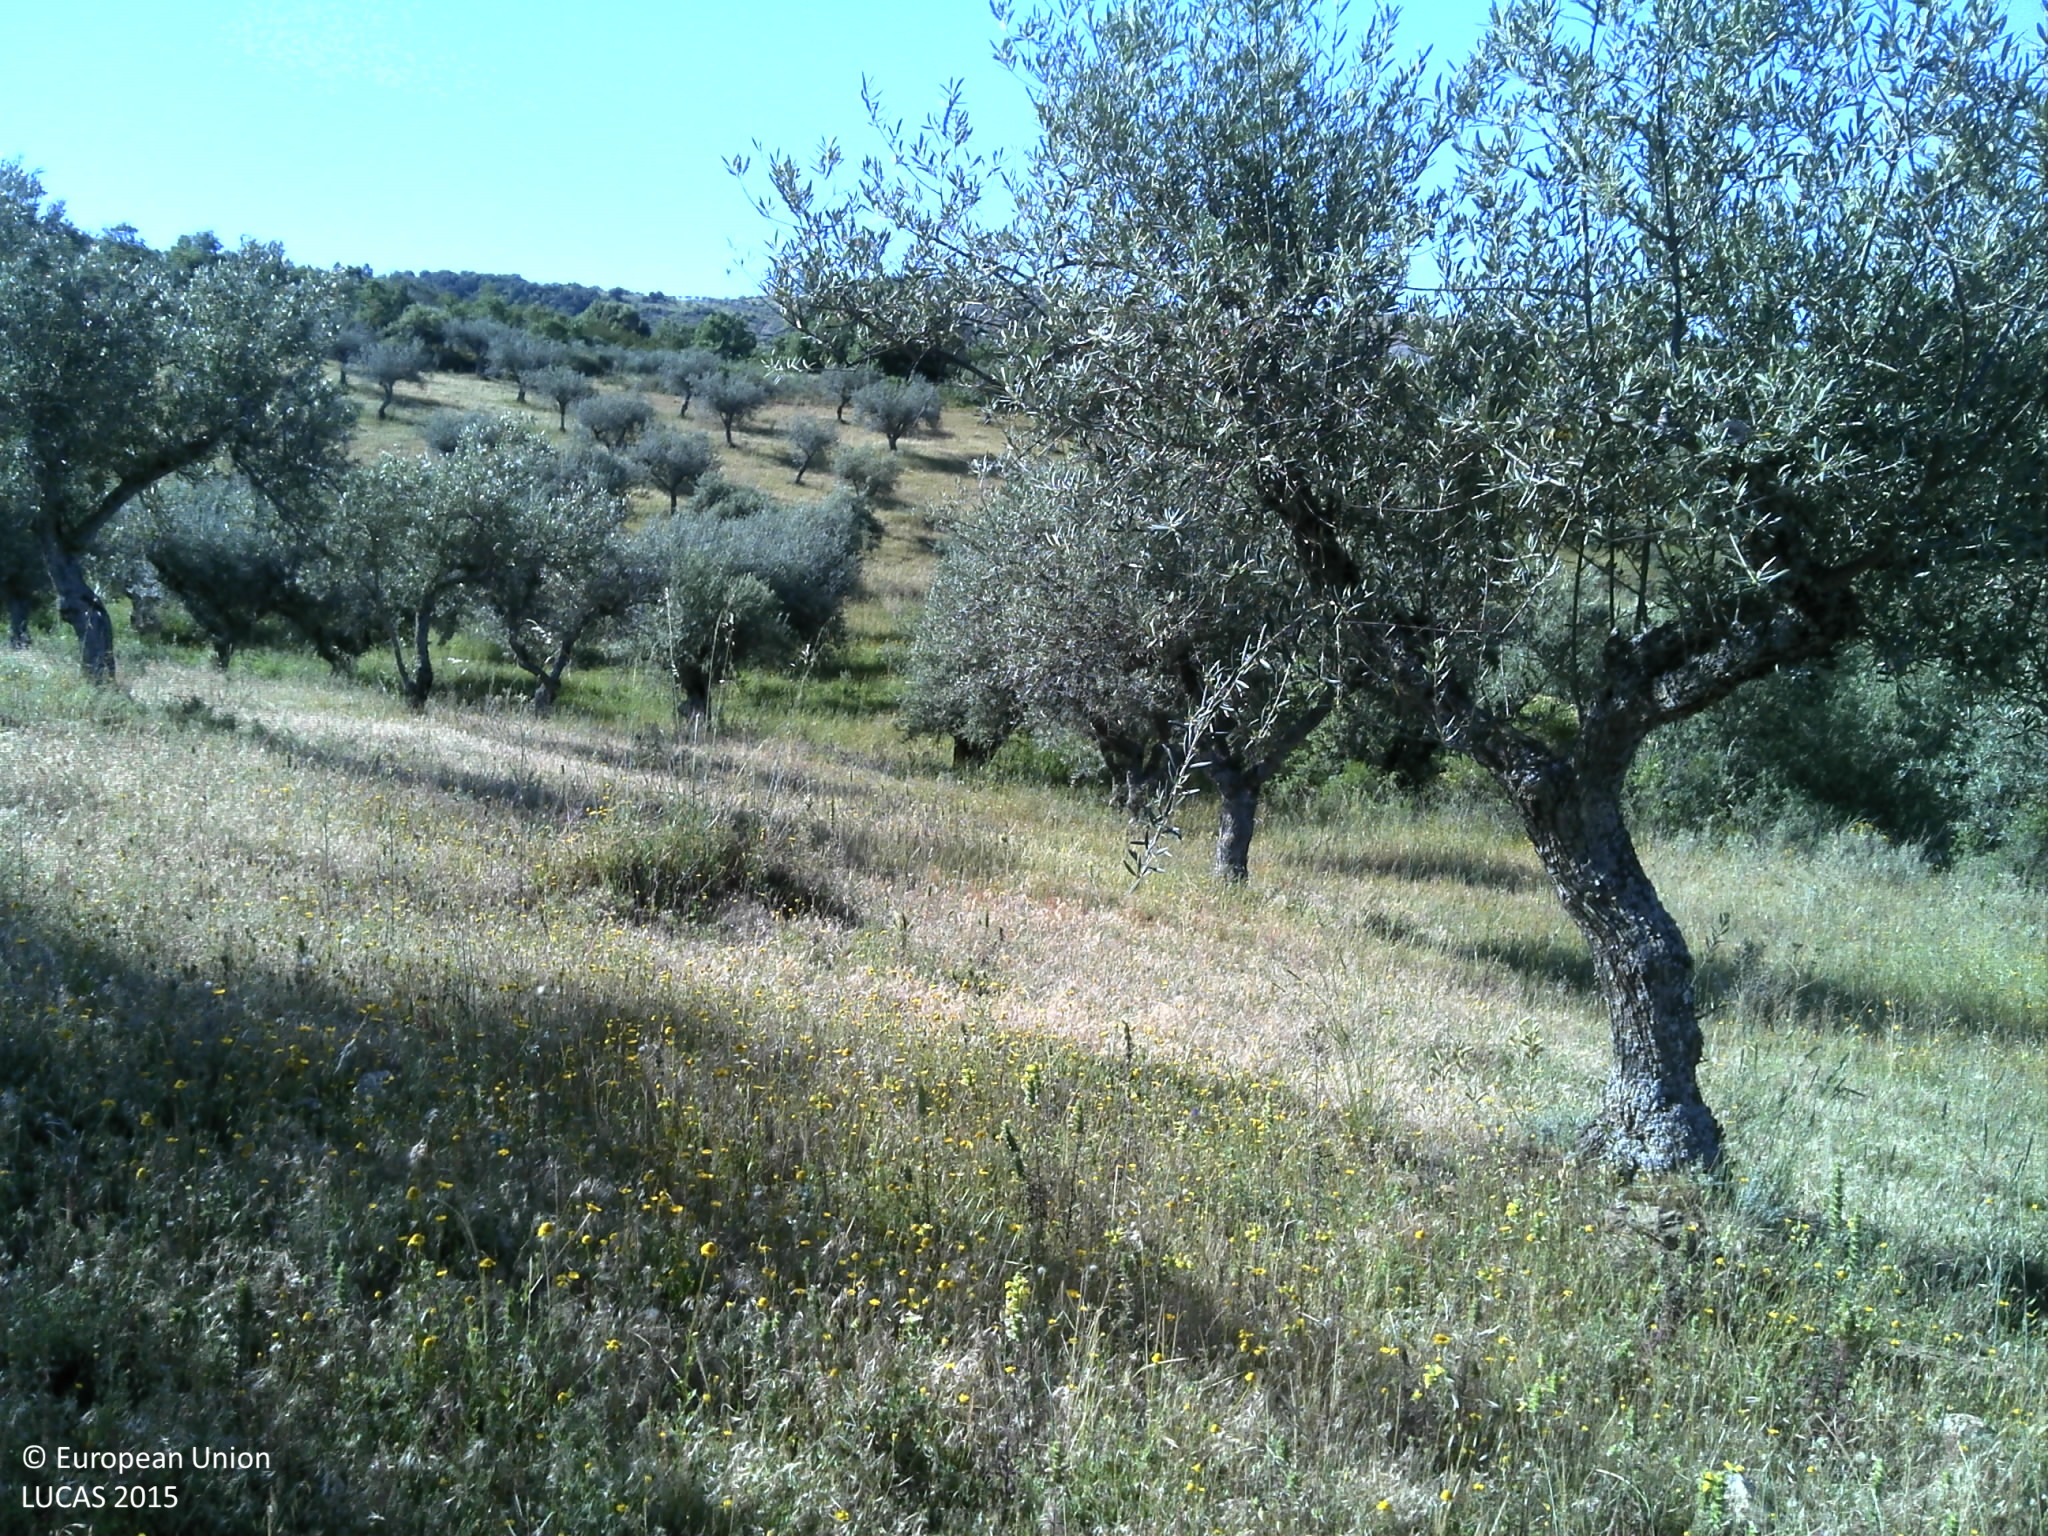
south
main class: Cropland
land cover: Olive groves
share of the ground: 25 - 50 %
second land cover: Grassland without tree/shrub cover
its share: 50 - 75 %
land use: Agriculture (excluding fallow land and kitchen gardens)
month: May
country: PT
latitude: 41.5678
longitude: -7.1356
